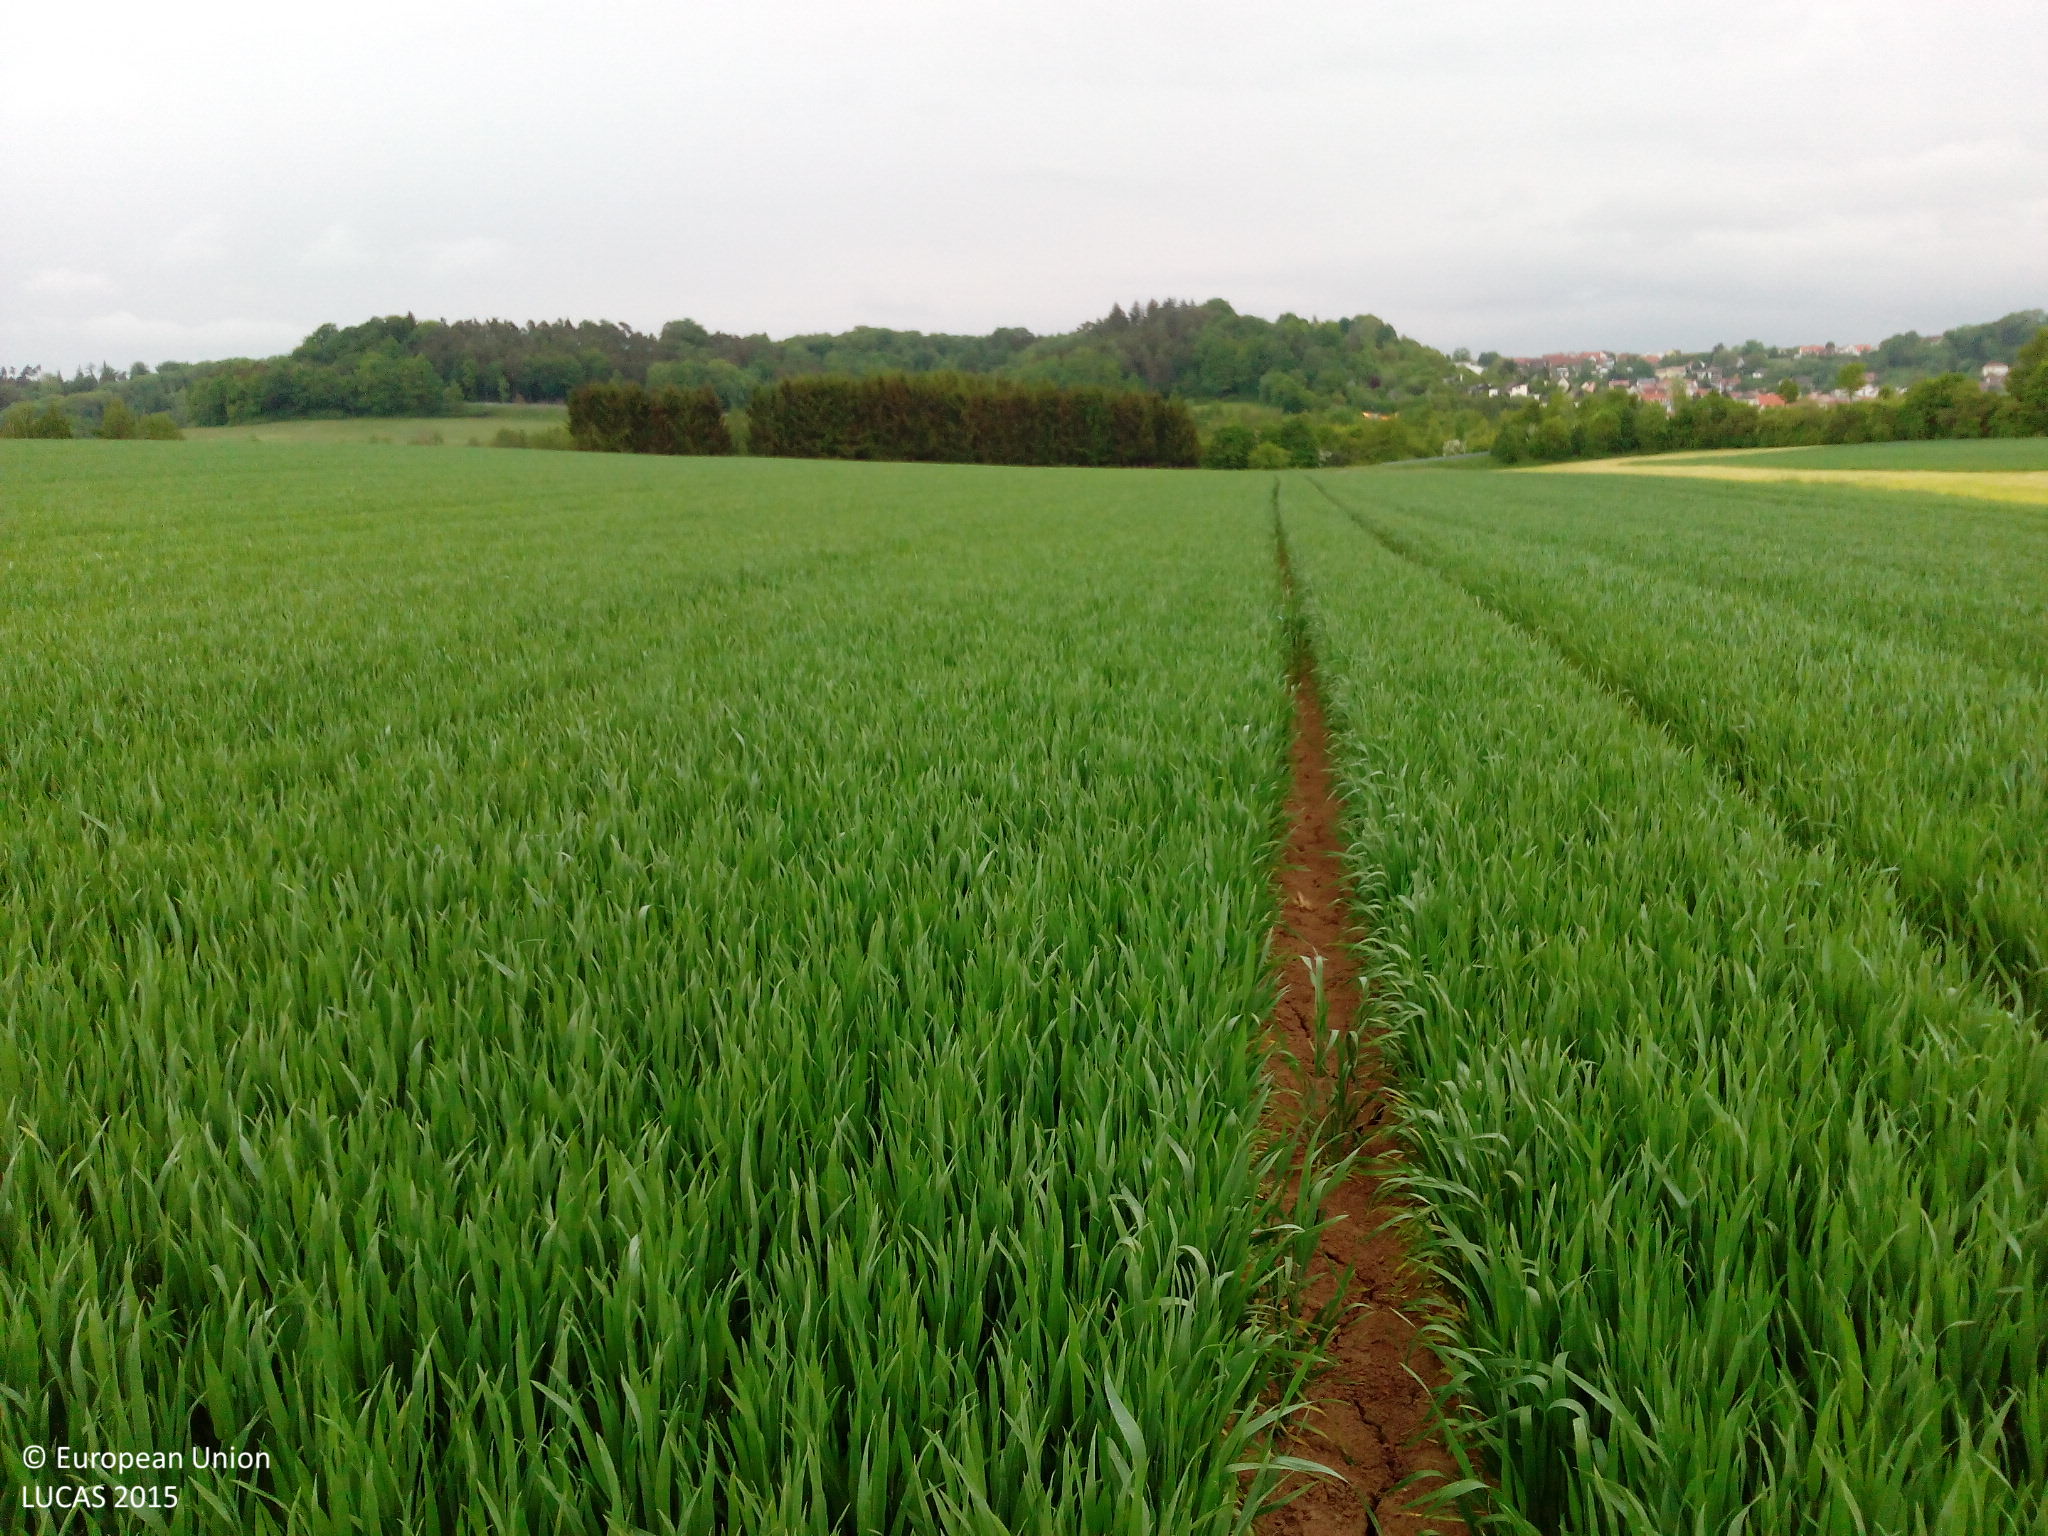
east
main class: Cropland
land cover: Common wheat
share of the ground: > 75 %
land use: Agriculture (excluding fallow land and kitchen gardens)
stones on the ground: < 10 %
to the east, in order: Common wheat
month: May
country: DE
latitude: 49.1766
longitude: 10.3154
